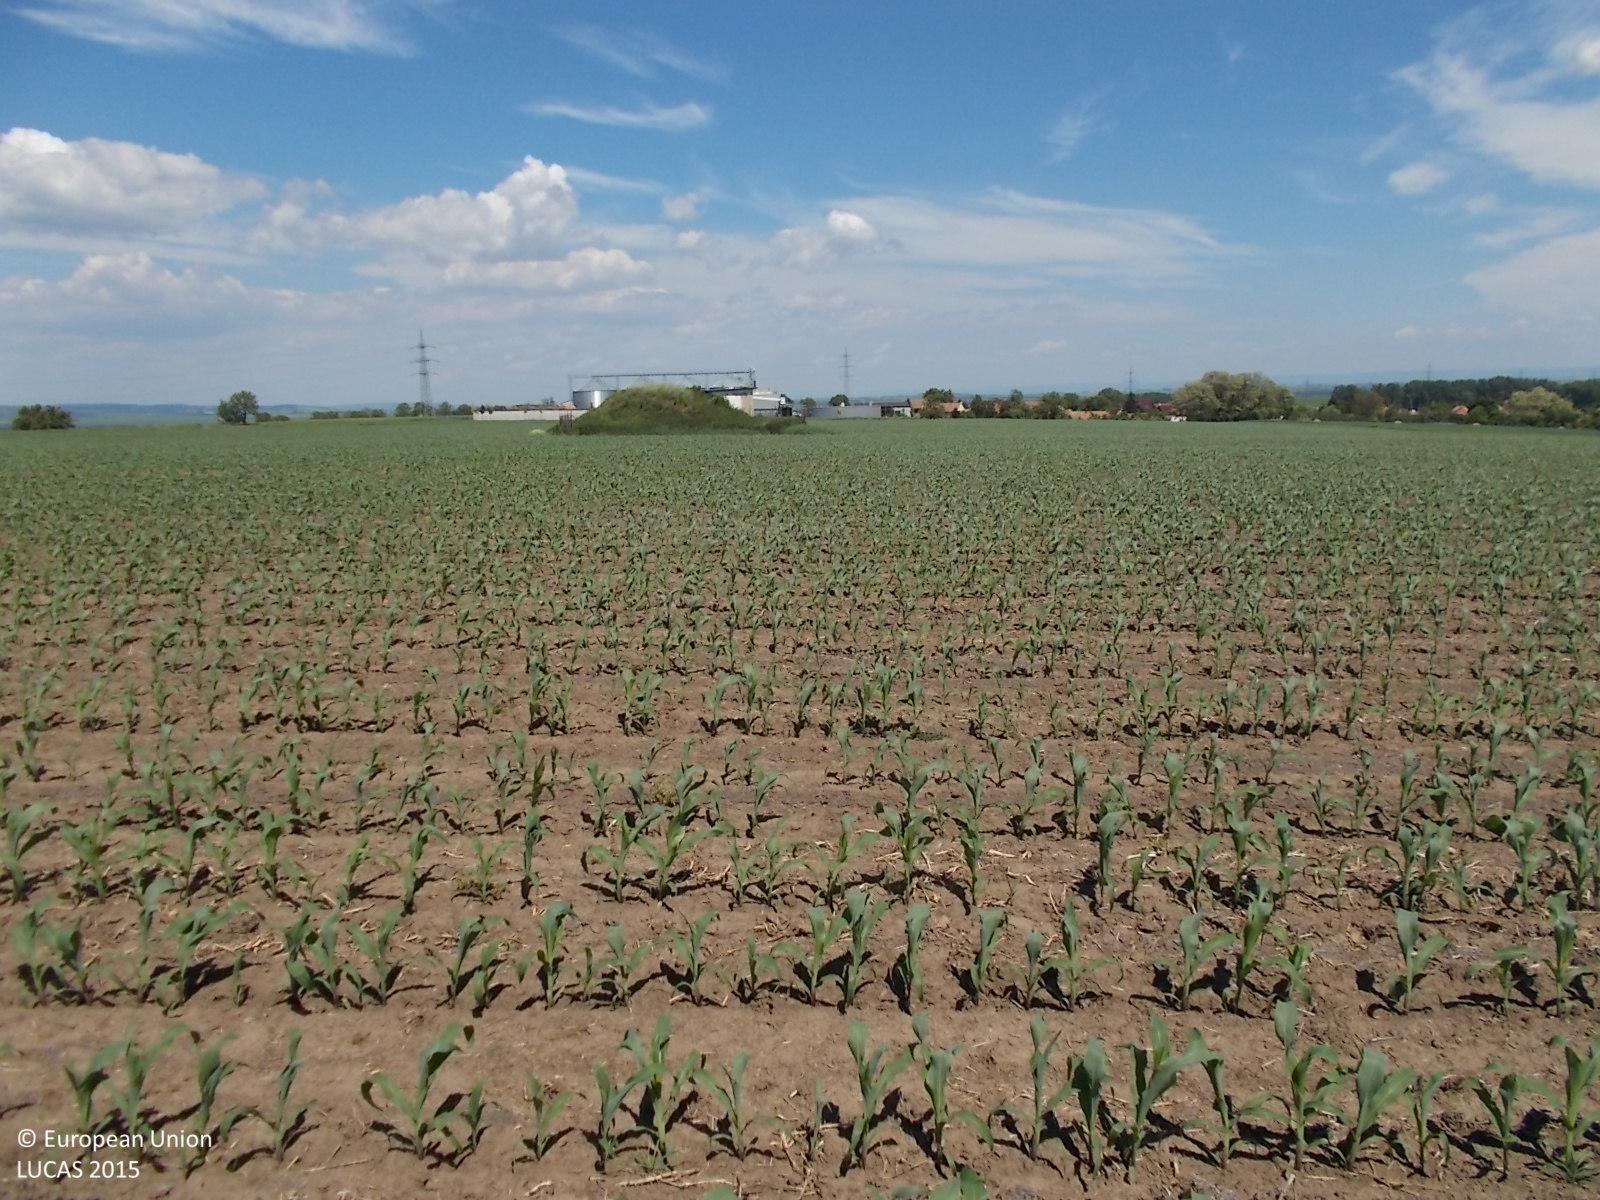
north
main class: Cropland
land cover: Maize
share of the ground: 25 - 50 %
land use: Agriculture (excluding fallow land and kitchen gardens)
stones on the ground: < 10 %
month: June
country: CZ
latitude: 49.2757
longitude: 17.1160
